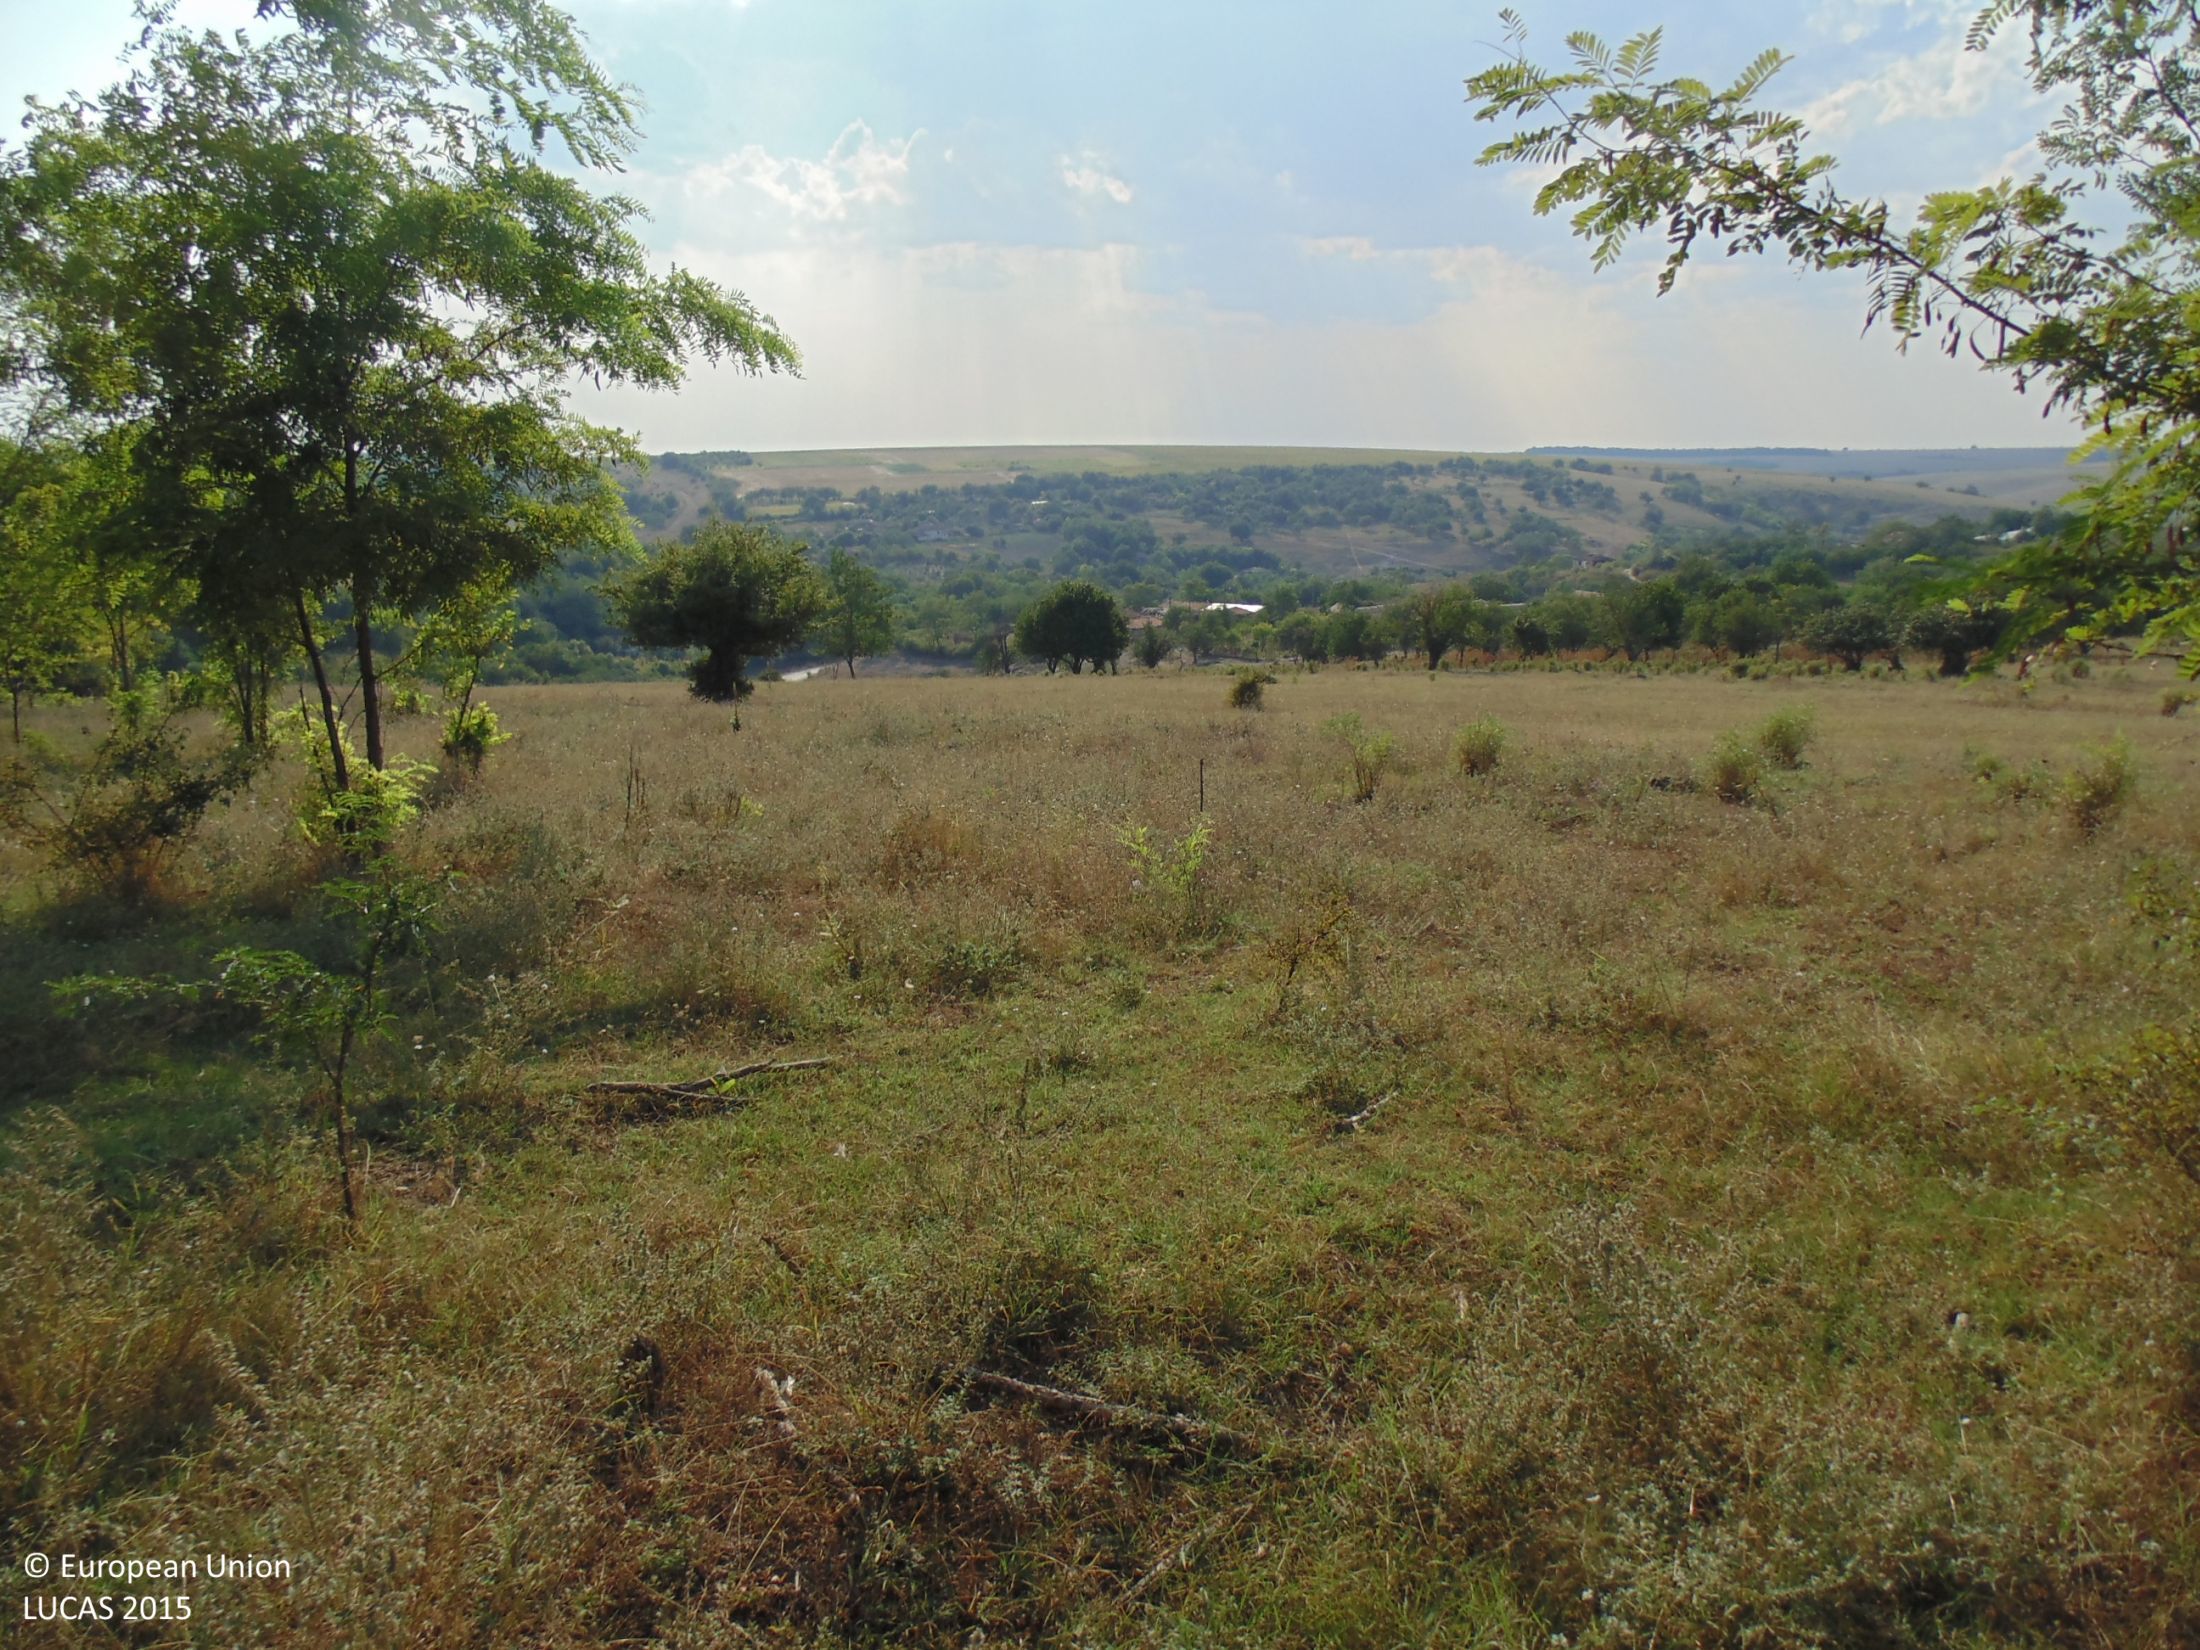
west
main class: Woodland
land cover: Broadleaved woodland
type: mesophytic deciduous forest
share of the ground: > 75 %
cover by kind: broadleaved forest trees 90 %, shrubs 5 %, unconsolidated bare surface 5 %
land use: Forestry
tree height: > 5 m
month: August
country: BG
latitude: 43.9512
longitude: 27.5197
